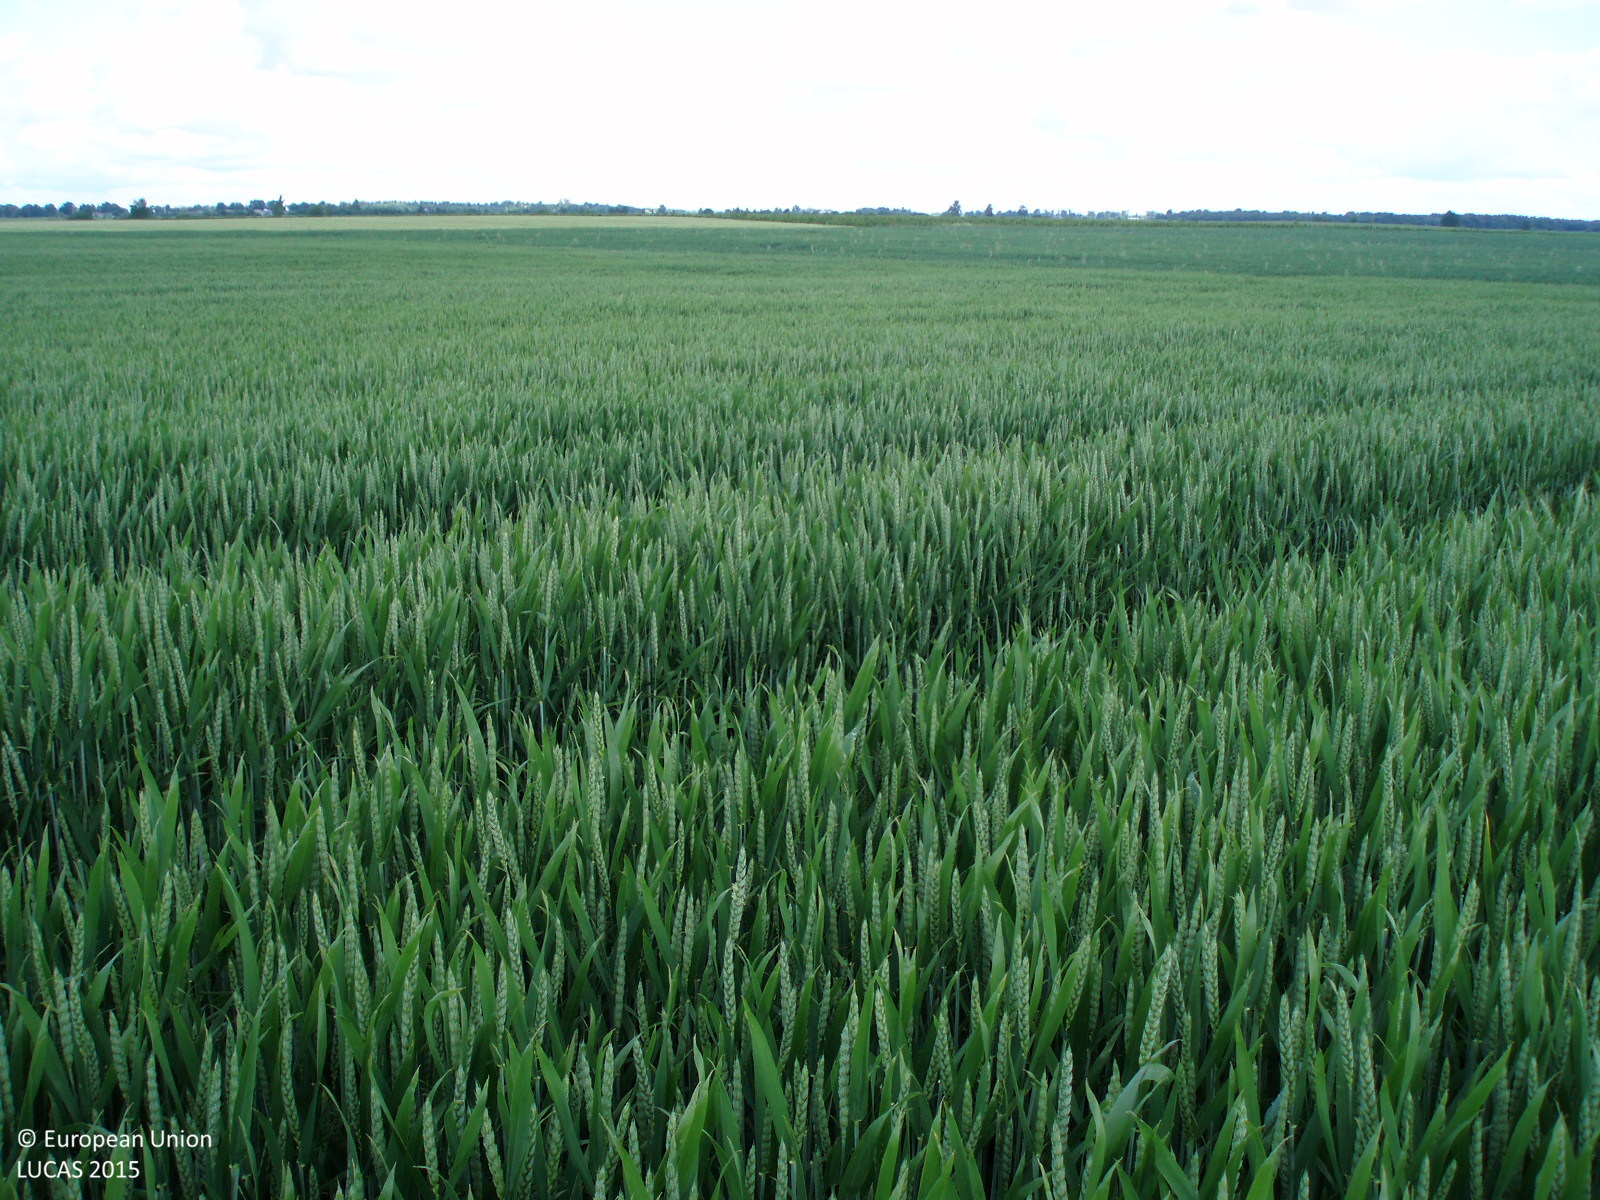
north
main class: Cropland
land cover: Common wheat
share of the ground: > 75 %
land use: Agriculture (excluding fallow land and kitchen gardens)
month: June
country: LT
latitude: 56.2972
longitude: 23.2736
